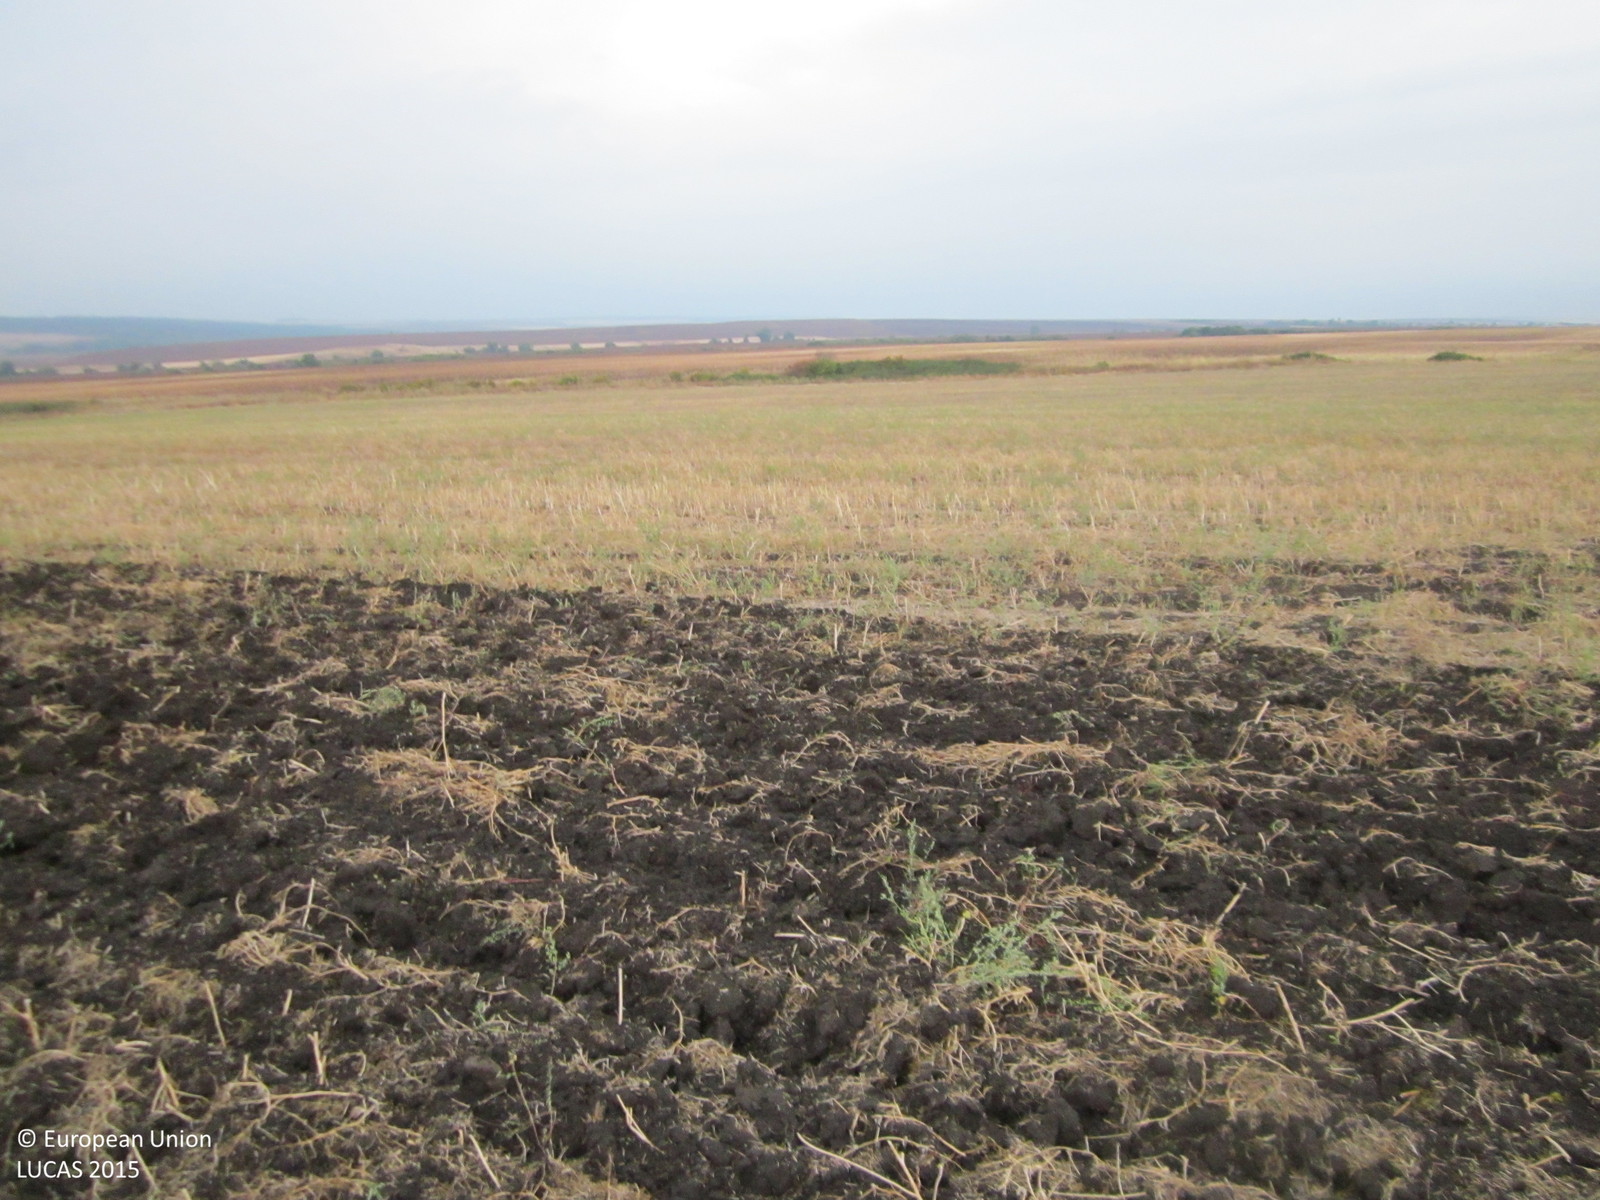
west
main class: Cropland
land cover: Rape and turnip rape
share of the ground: 10 - 25 %
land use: Agriculture (excluding fallow land and kitchen gardens)
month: August
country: BG
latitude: 42.5102
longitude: 27.0099
